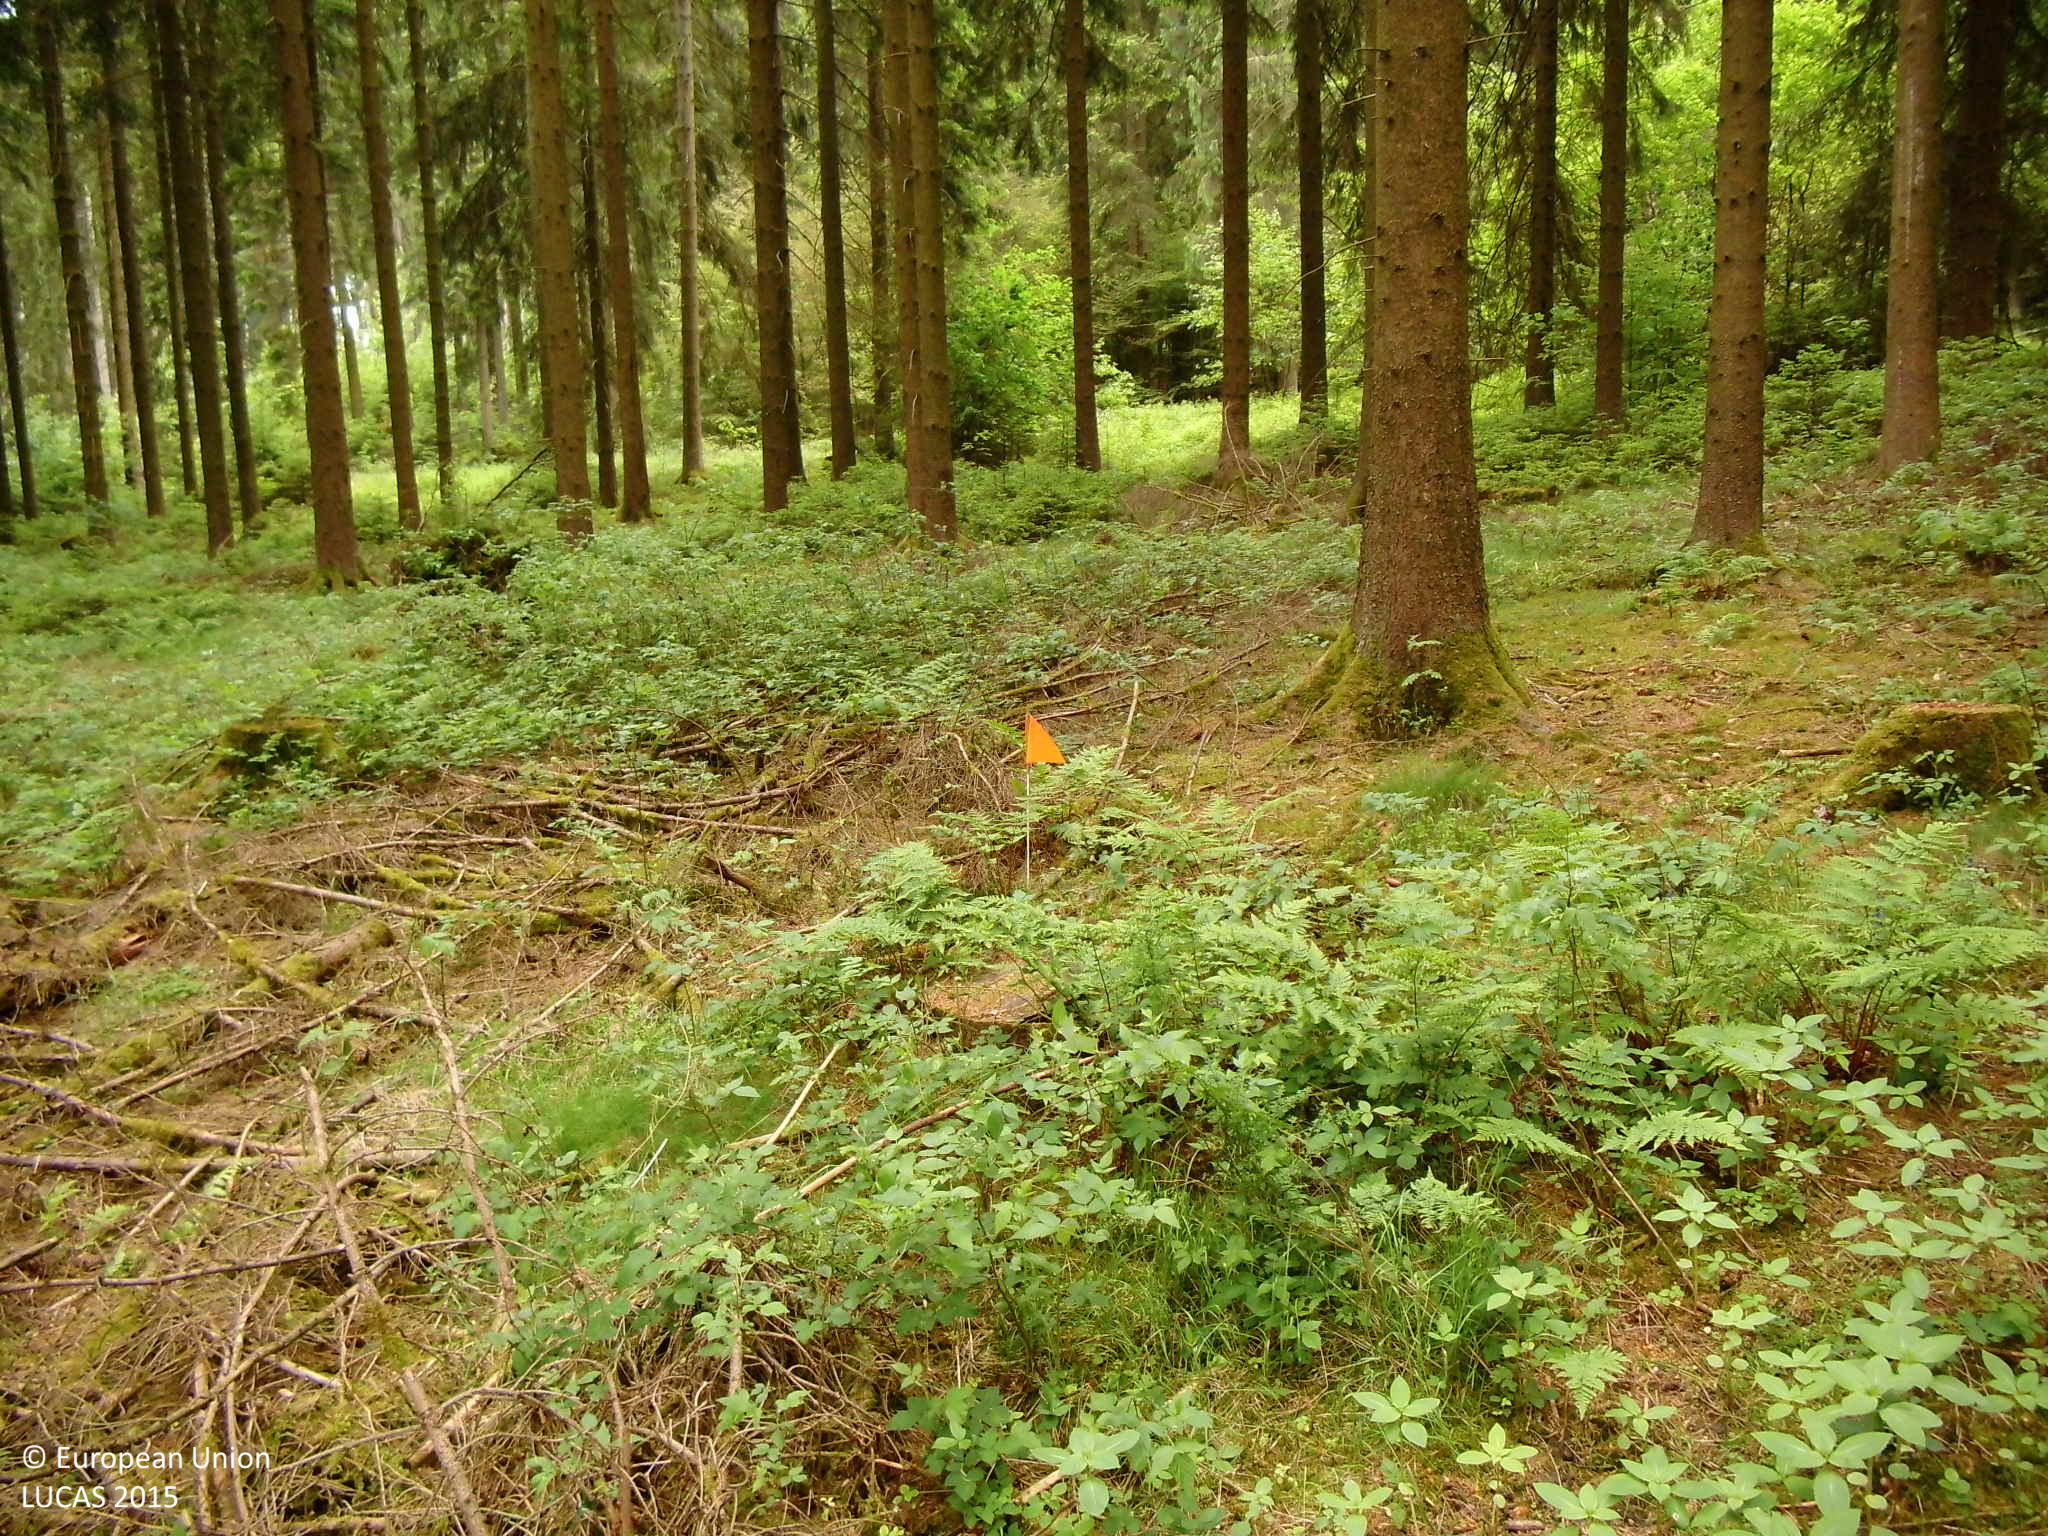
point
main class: Woodland
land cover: Spruce dominated coniferous woodland
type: hemiboreal forest and nemoral coniferous forest and mixed broadleaved-coniferous forest
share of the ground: > 75 %
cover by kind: coniferous forest trees 75 %, shrubs 10 %, lichens and mosses 10 %, herbaceous plants 5 %
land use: Forestry
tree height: > 5 m
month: June
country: DE
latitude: 51.0488
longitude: 8.0461
